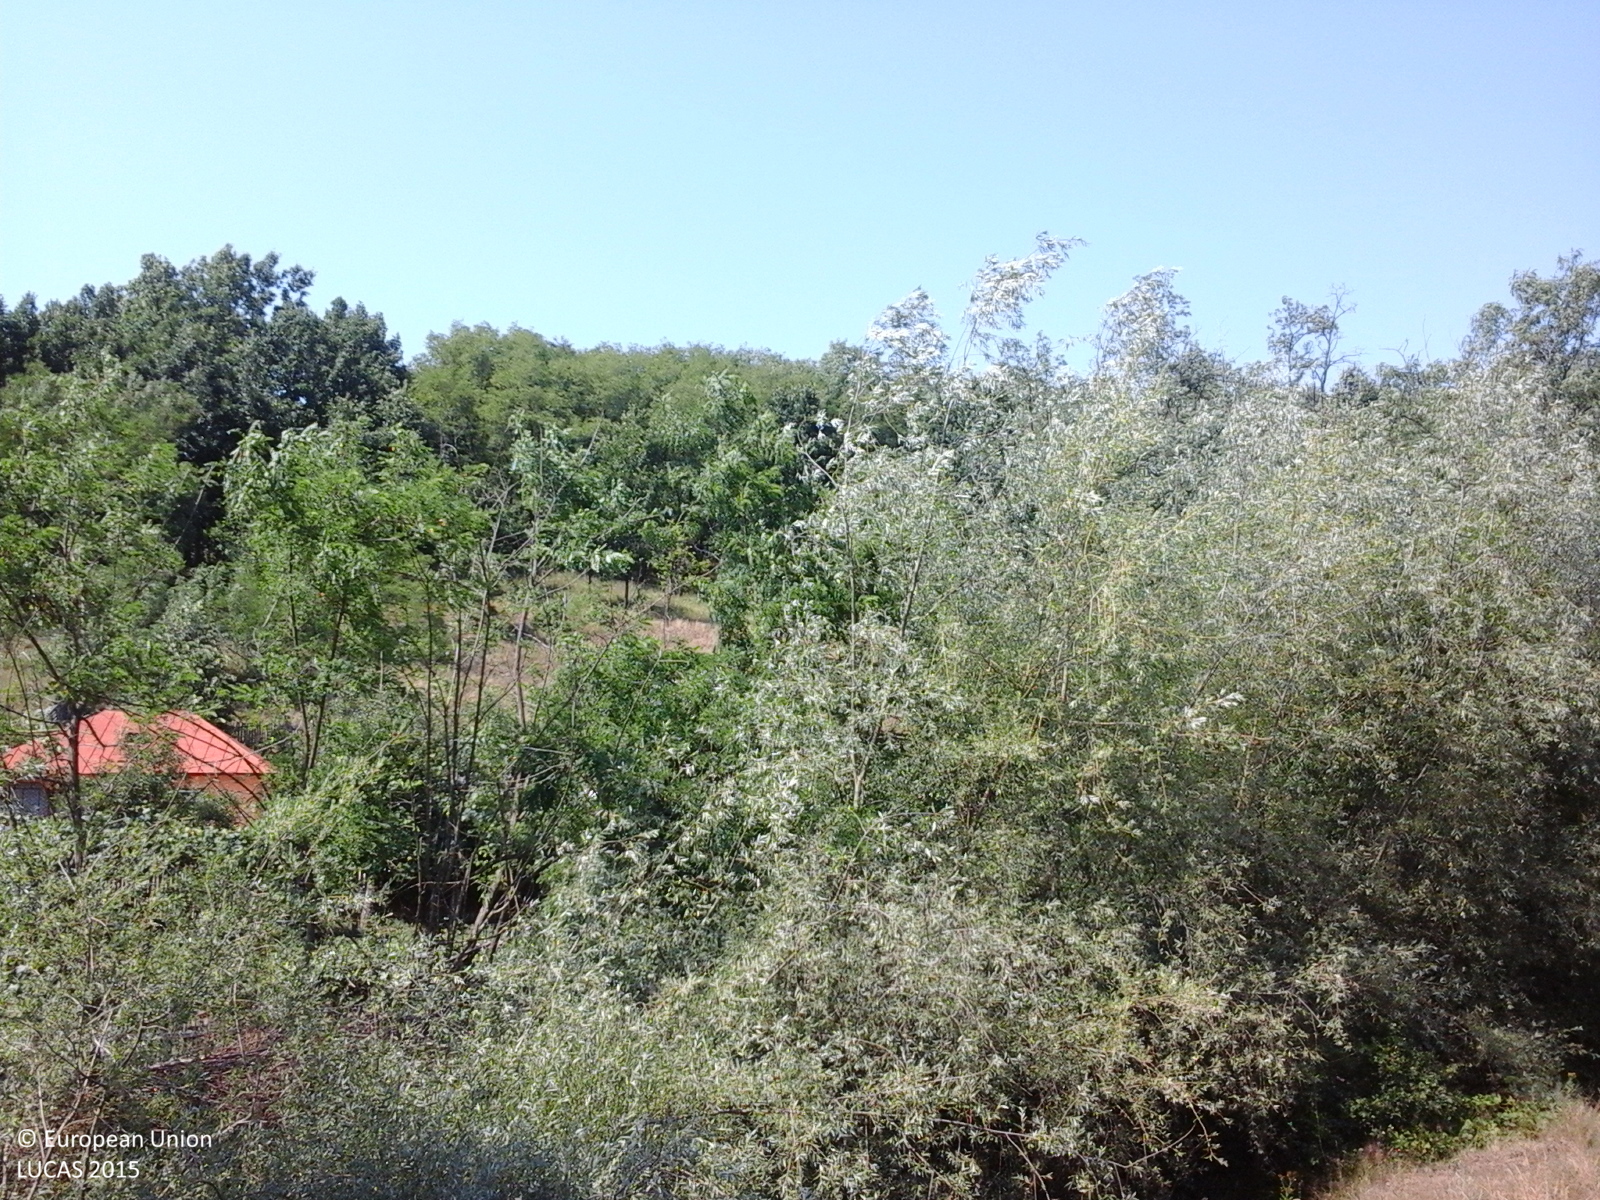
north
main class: Grassland
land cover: Grassland without tree/shrub cover
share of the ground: 50 - 75 %
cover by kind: herbaceous plants 100 %
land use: Agriculture (excluding fallow land and kitchen gardens)
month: July
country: RO
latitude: 44.8713
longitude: 24.4395
